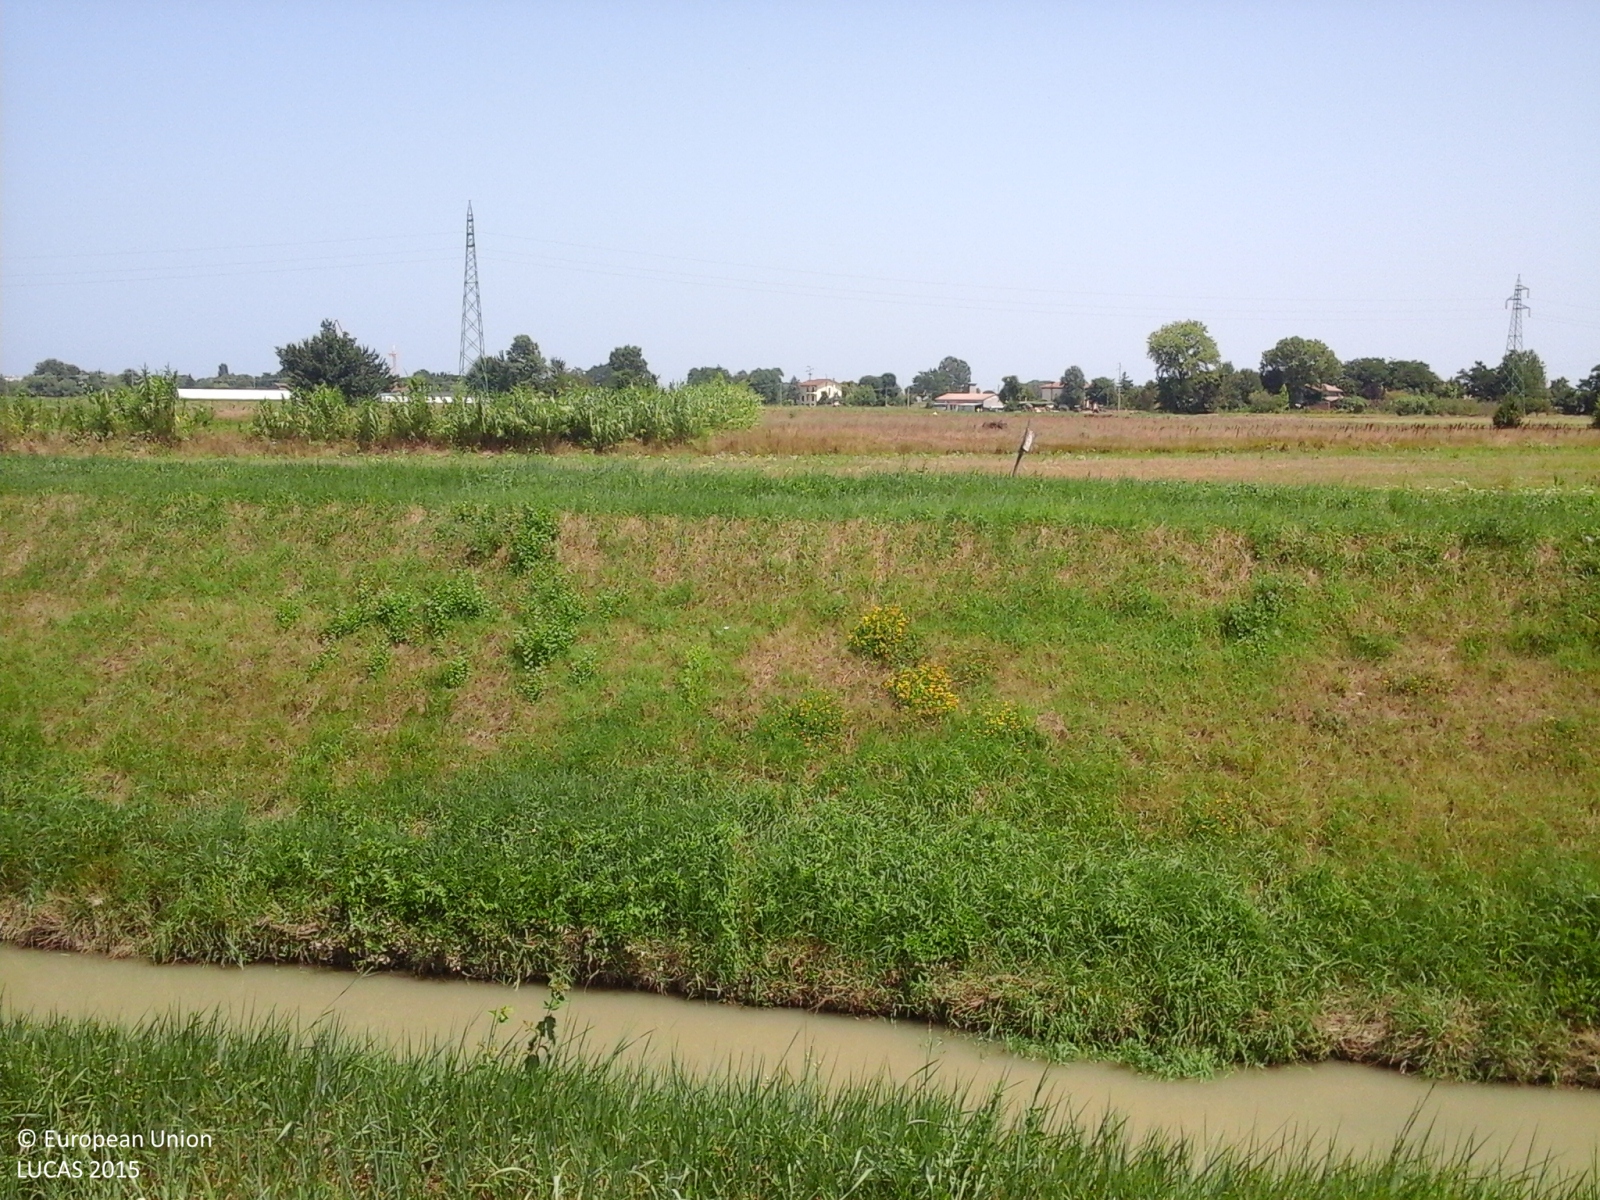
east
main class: Grassland
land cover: Grassland without tree/shrub cover
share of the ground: > 75 %
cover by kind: herbaceous plants 100 %
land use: Semi-natural and natural areas not in use
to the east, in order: Grassland without tree/shrub cover; Inland fresh running water; Grassland without tree/shrub cover; Spontaneously vegetated surfaces; Common wheat; Ditches and canals; Common wheat; Spontaneously vegetated surfaces; Ditches and canals; Spontaneously vegetated surfaces
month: July
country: IT
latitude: 44.1602
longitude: 12.4080
